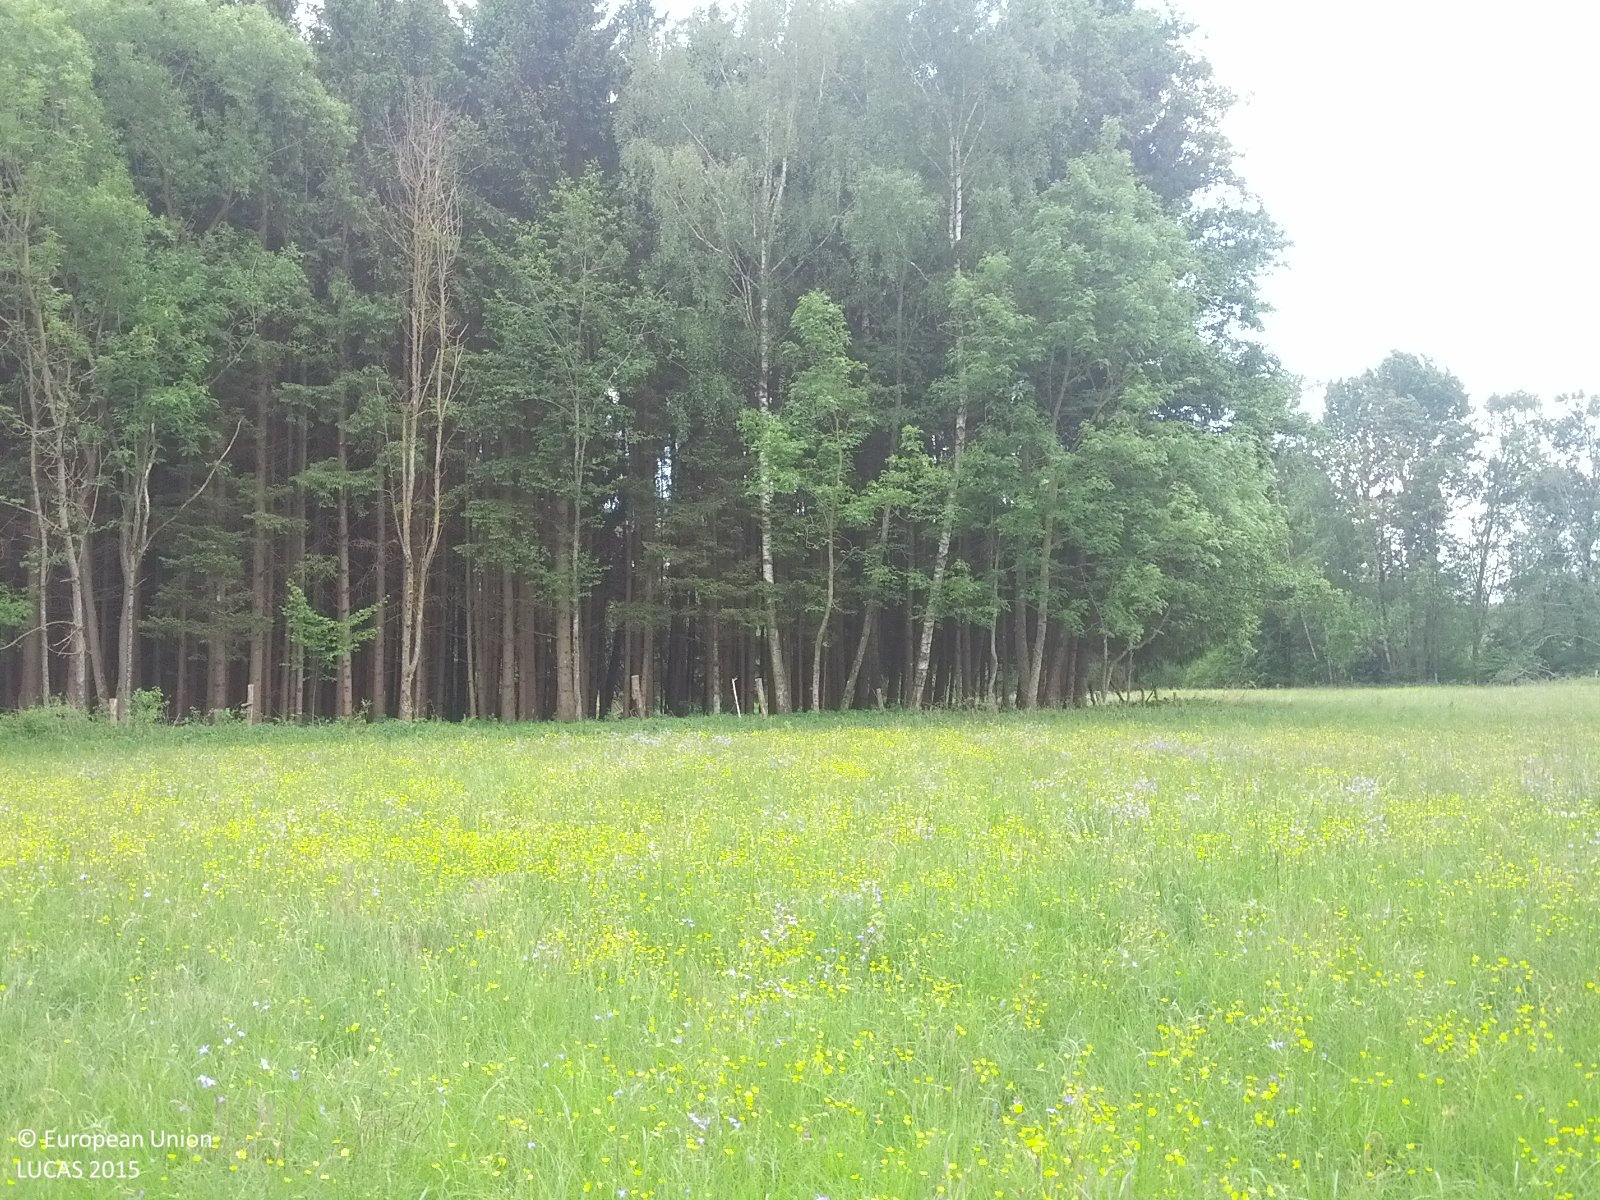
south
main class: Grassland
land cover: Grassland without tree/shrub cover
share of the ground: > 75 %
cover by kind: herbaceous plants 100 %
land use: Agriculture (excluding fallow land and kitchen gardens)
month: May
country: AT
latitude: 47.3355
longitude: 16.0499
